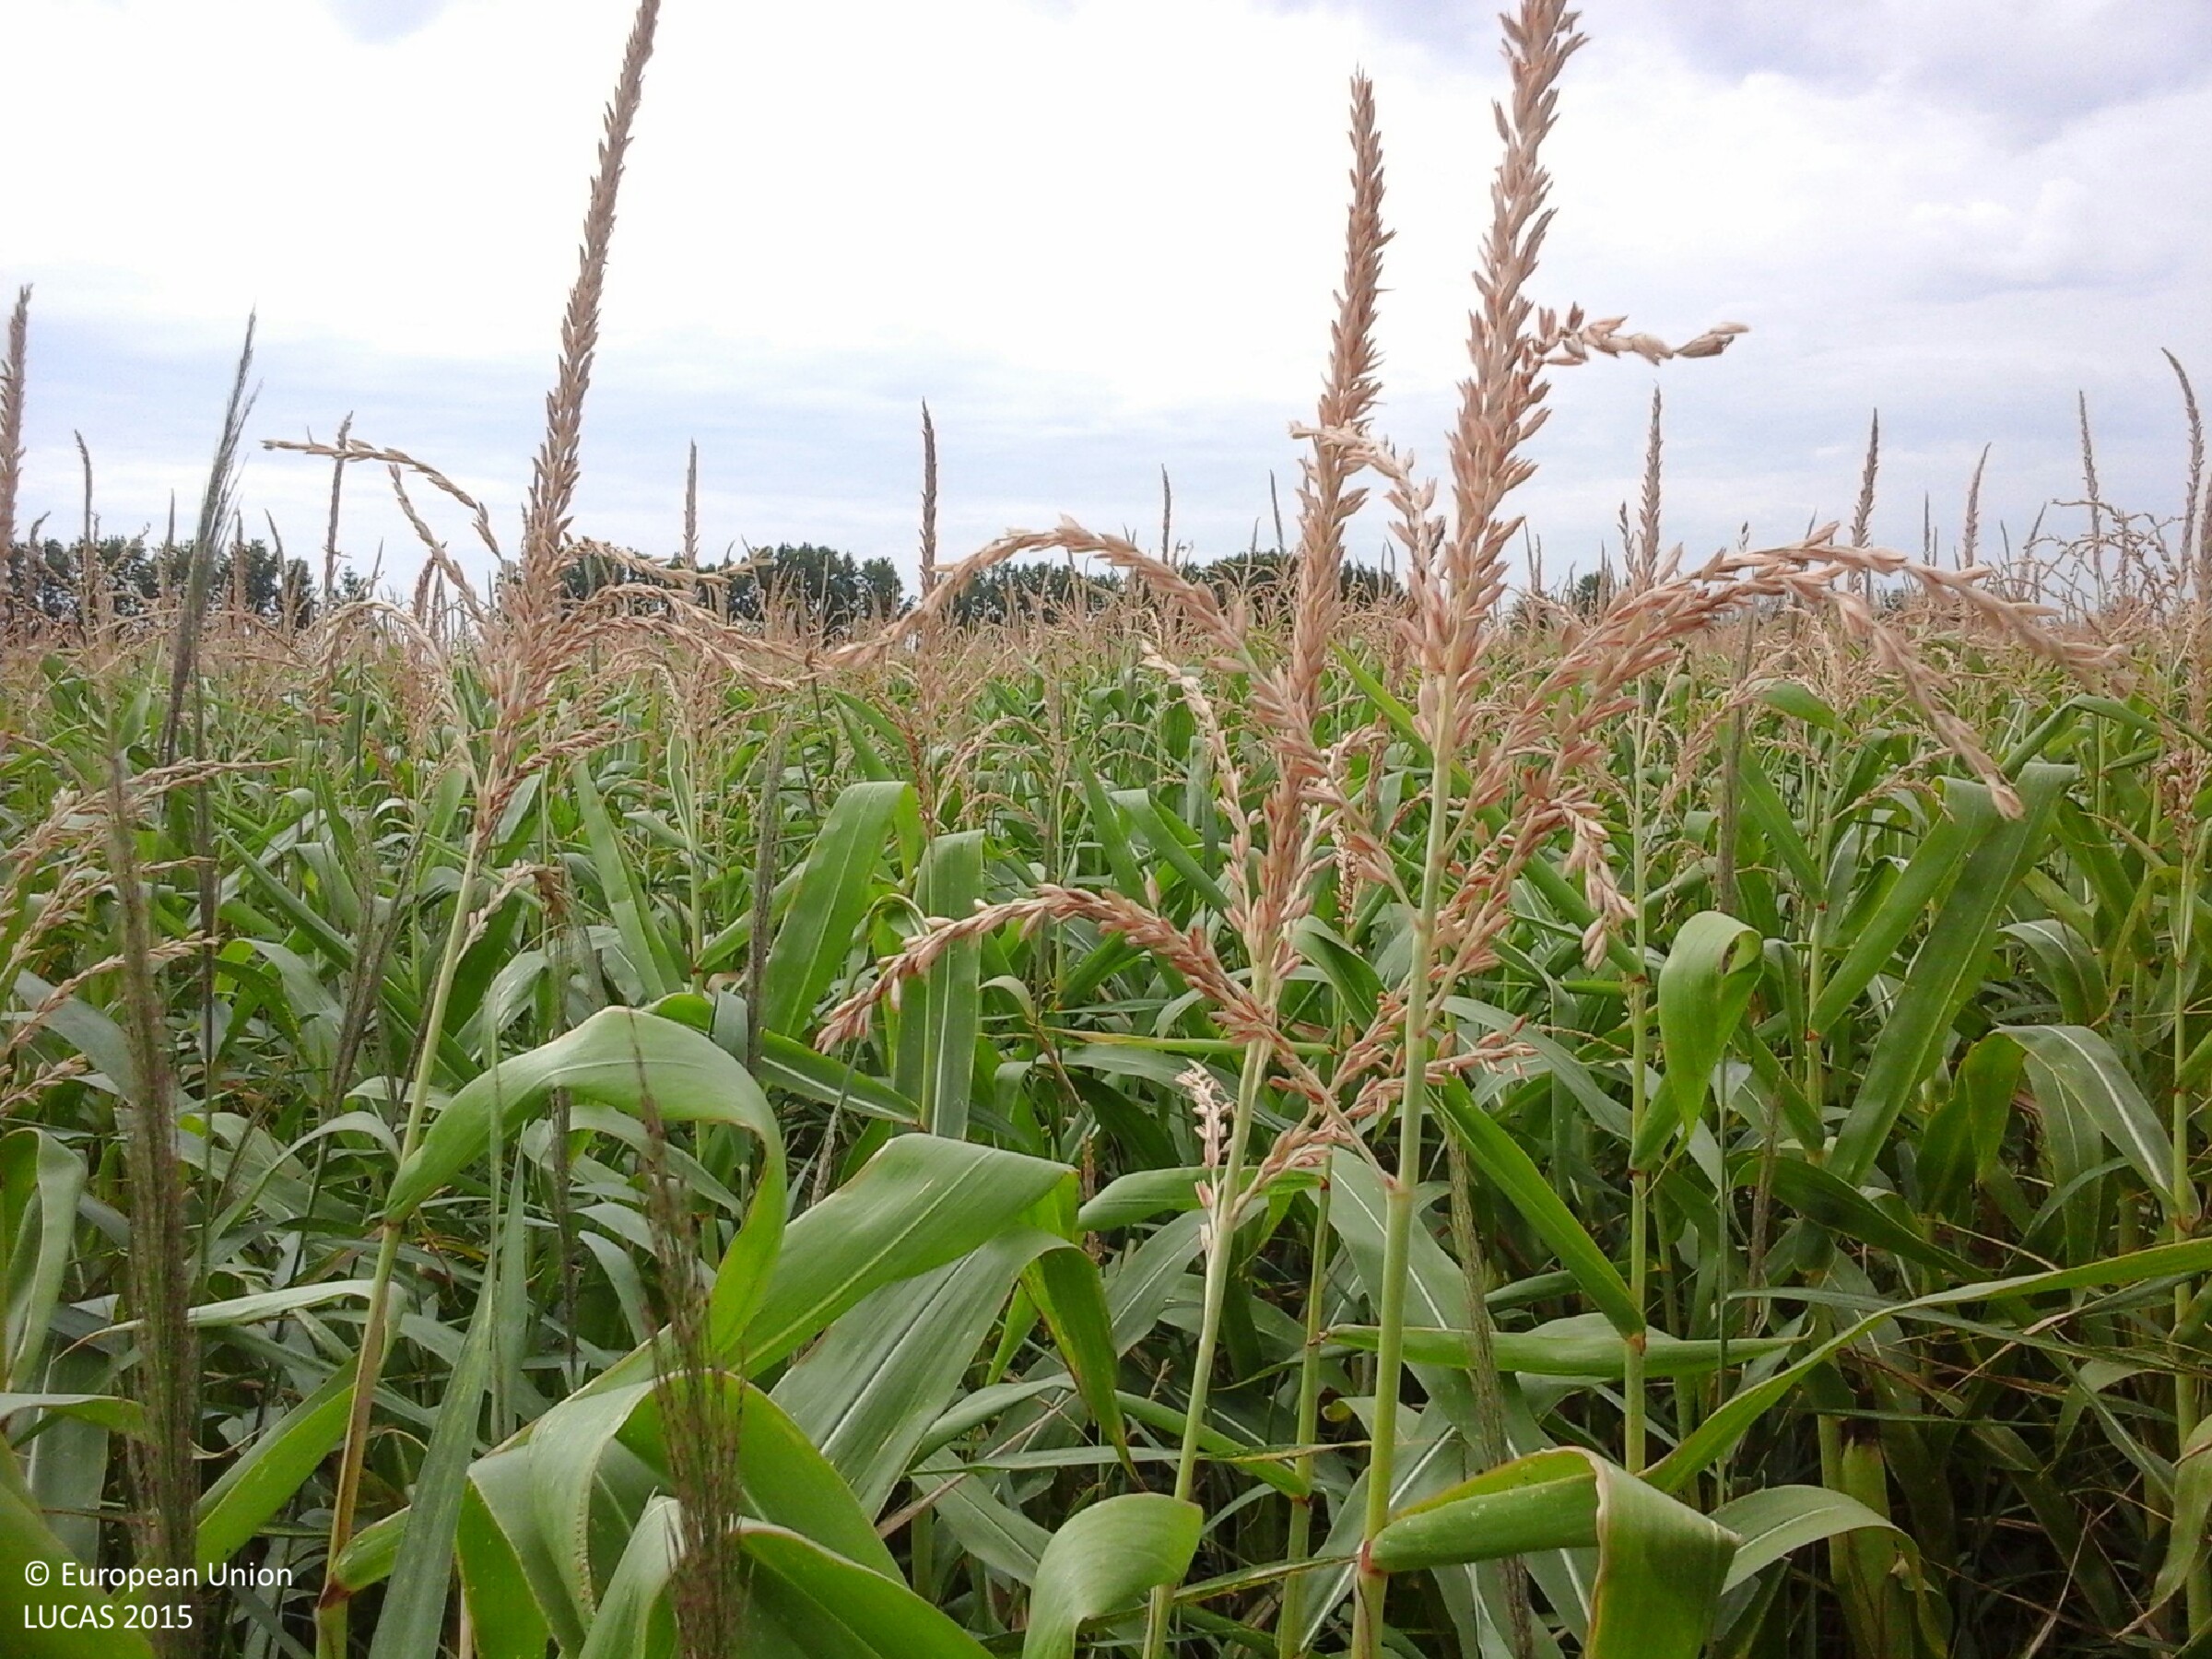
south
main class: Cropland
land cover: Maize
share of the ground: > 75 %
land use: Agriculture (excluding fallow land and kitchen gardens)
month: July
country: HU
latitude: 47.4055
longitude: 20.7538
